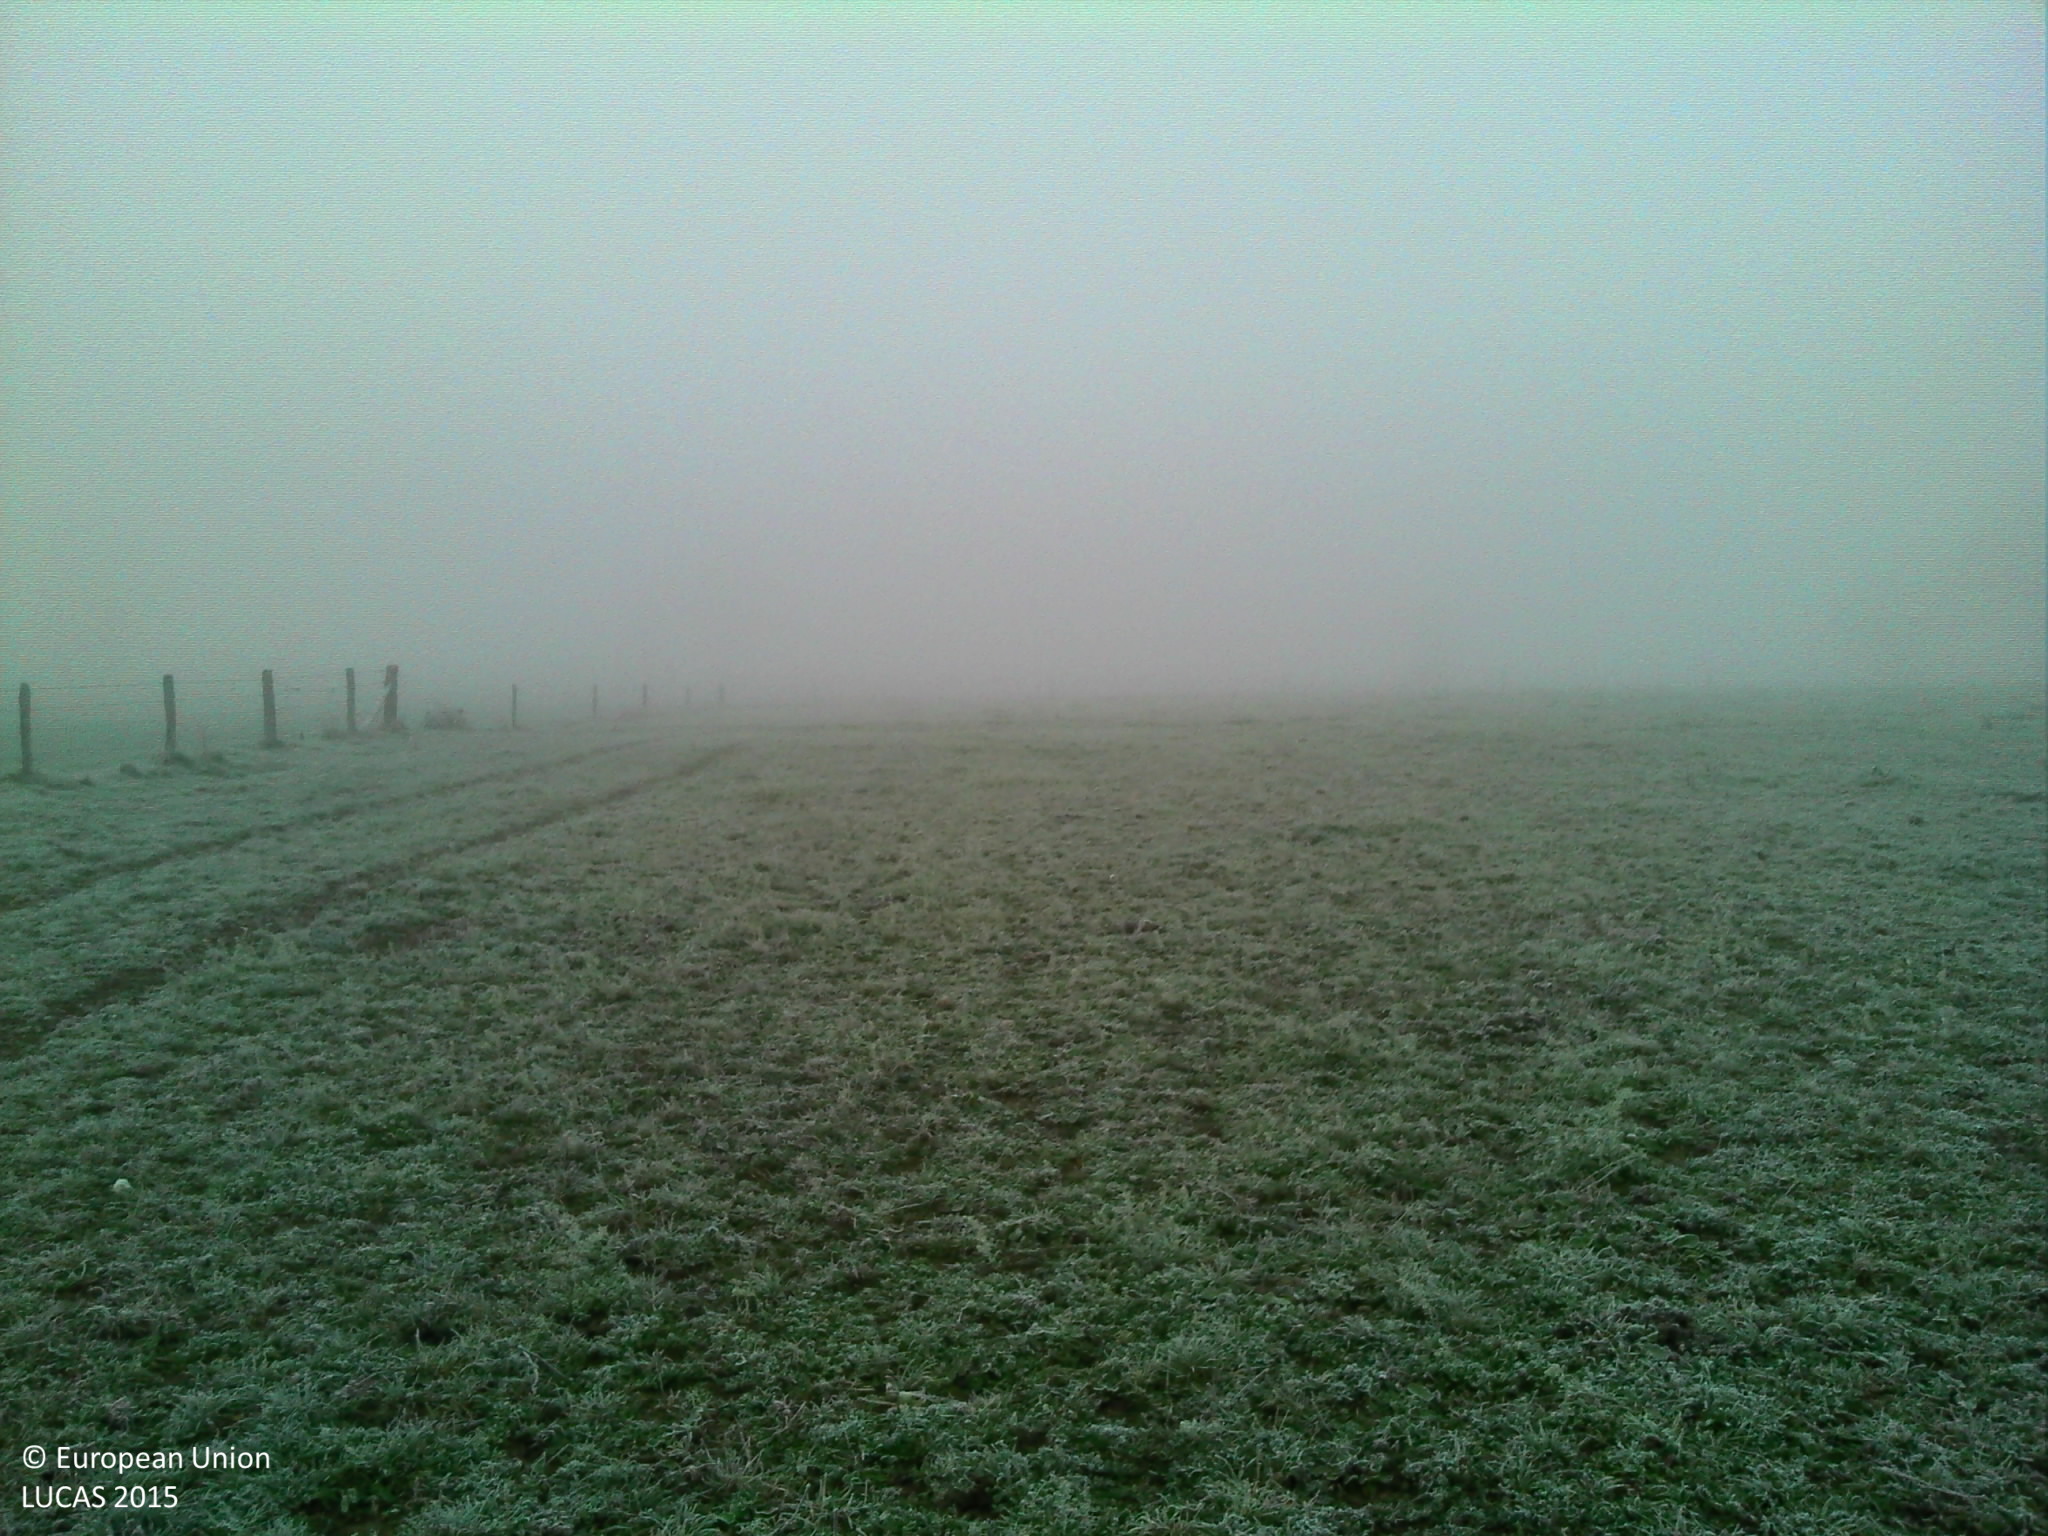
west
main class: Grassland
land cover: Grassland without tree/shrub cover
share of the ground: > 75 %
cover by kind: herbaceous plants 100 %
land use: Agriculture (excluding fallow land and kitchen gardens)
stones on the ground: < 10 %
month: November
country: FR
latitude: 46.5566
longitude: 3.5945
